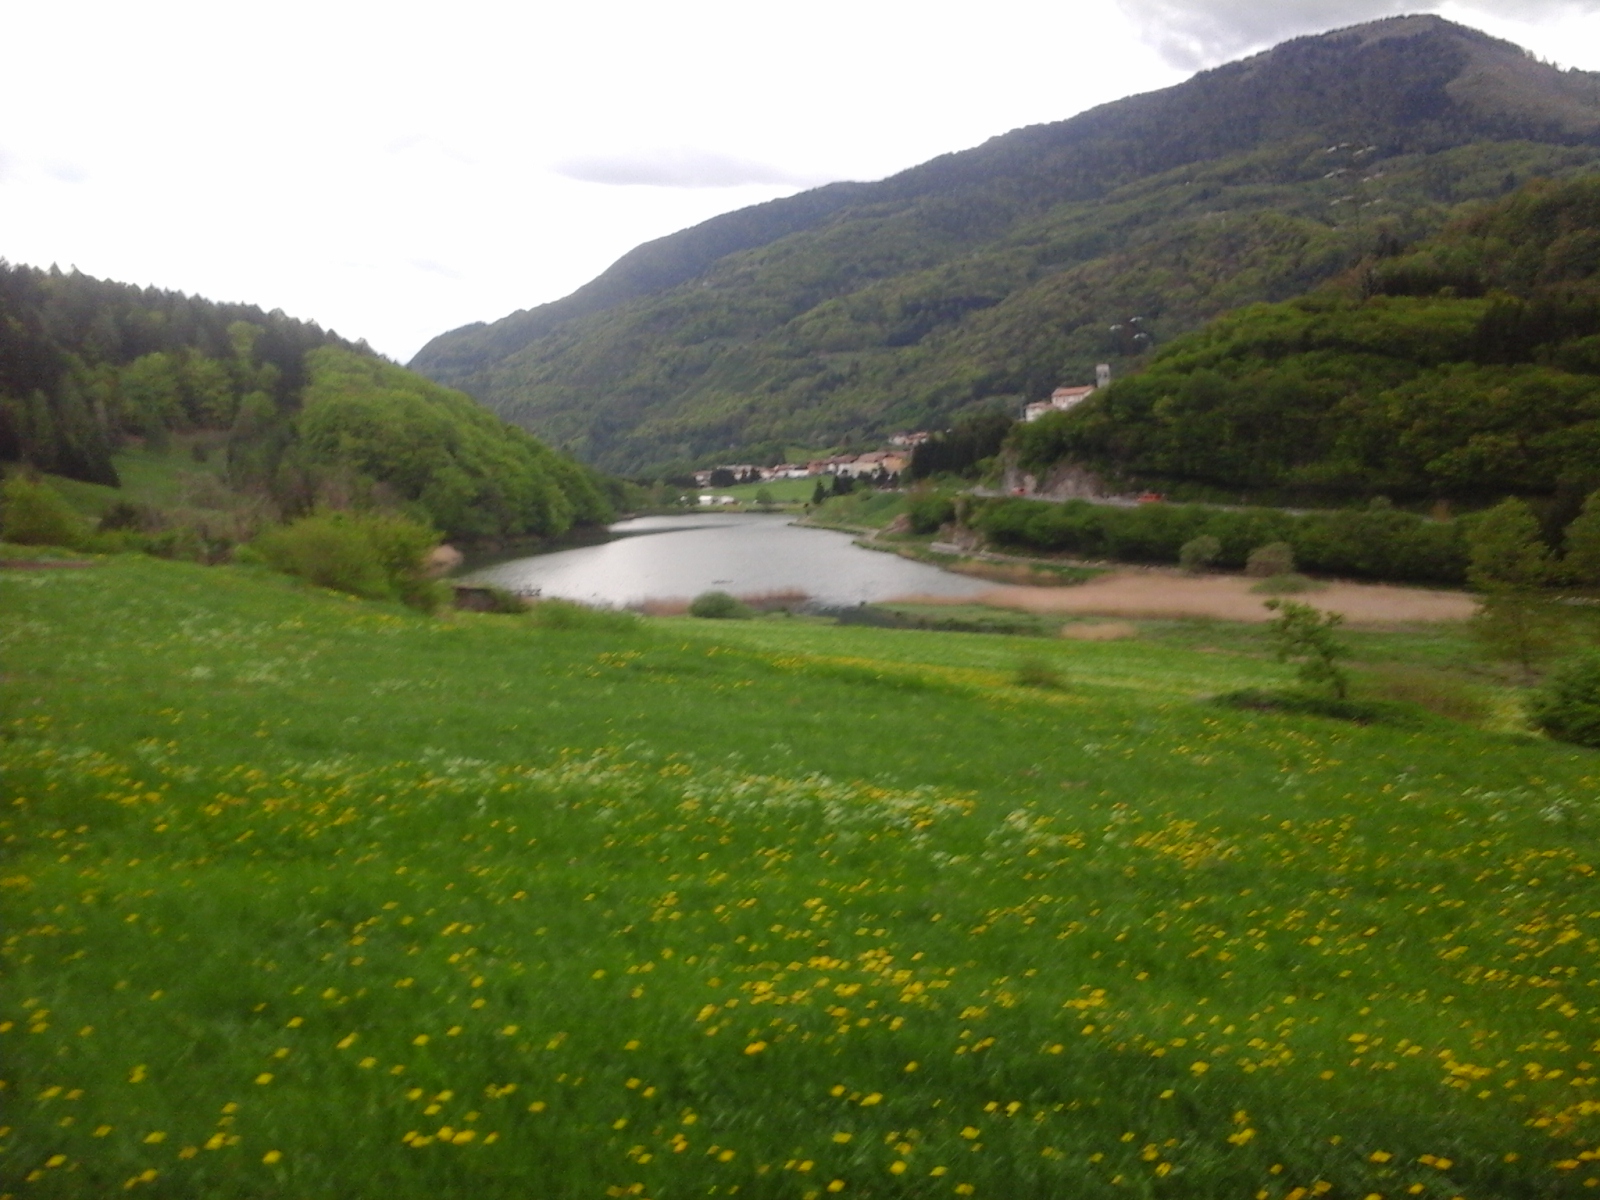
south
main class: Woodland
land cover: Spruce dominated mixed woodland
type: alpine coniferous forest
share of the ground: 25 - 50 %
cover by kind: coniferous forest trees 50 %, herbaceous plants 30 %, broadleaved forest trees 20 %
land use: Forestry
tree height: > 5 m
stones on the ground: > 50 %
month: May
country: IT
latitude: 45.9887
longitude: 10.6832
